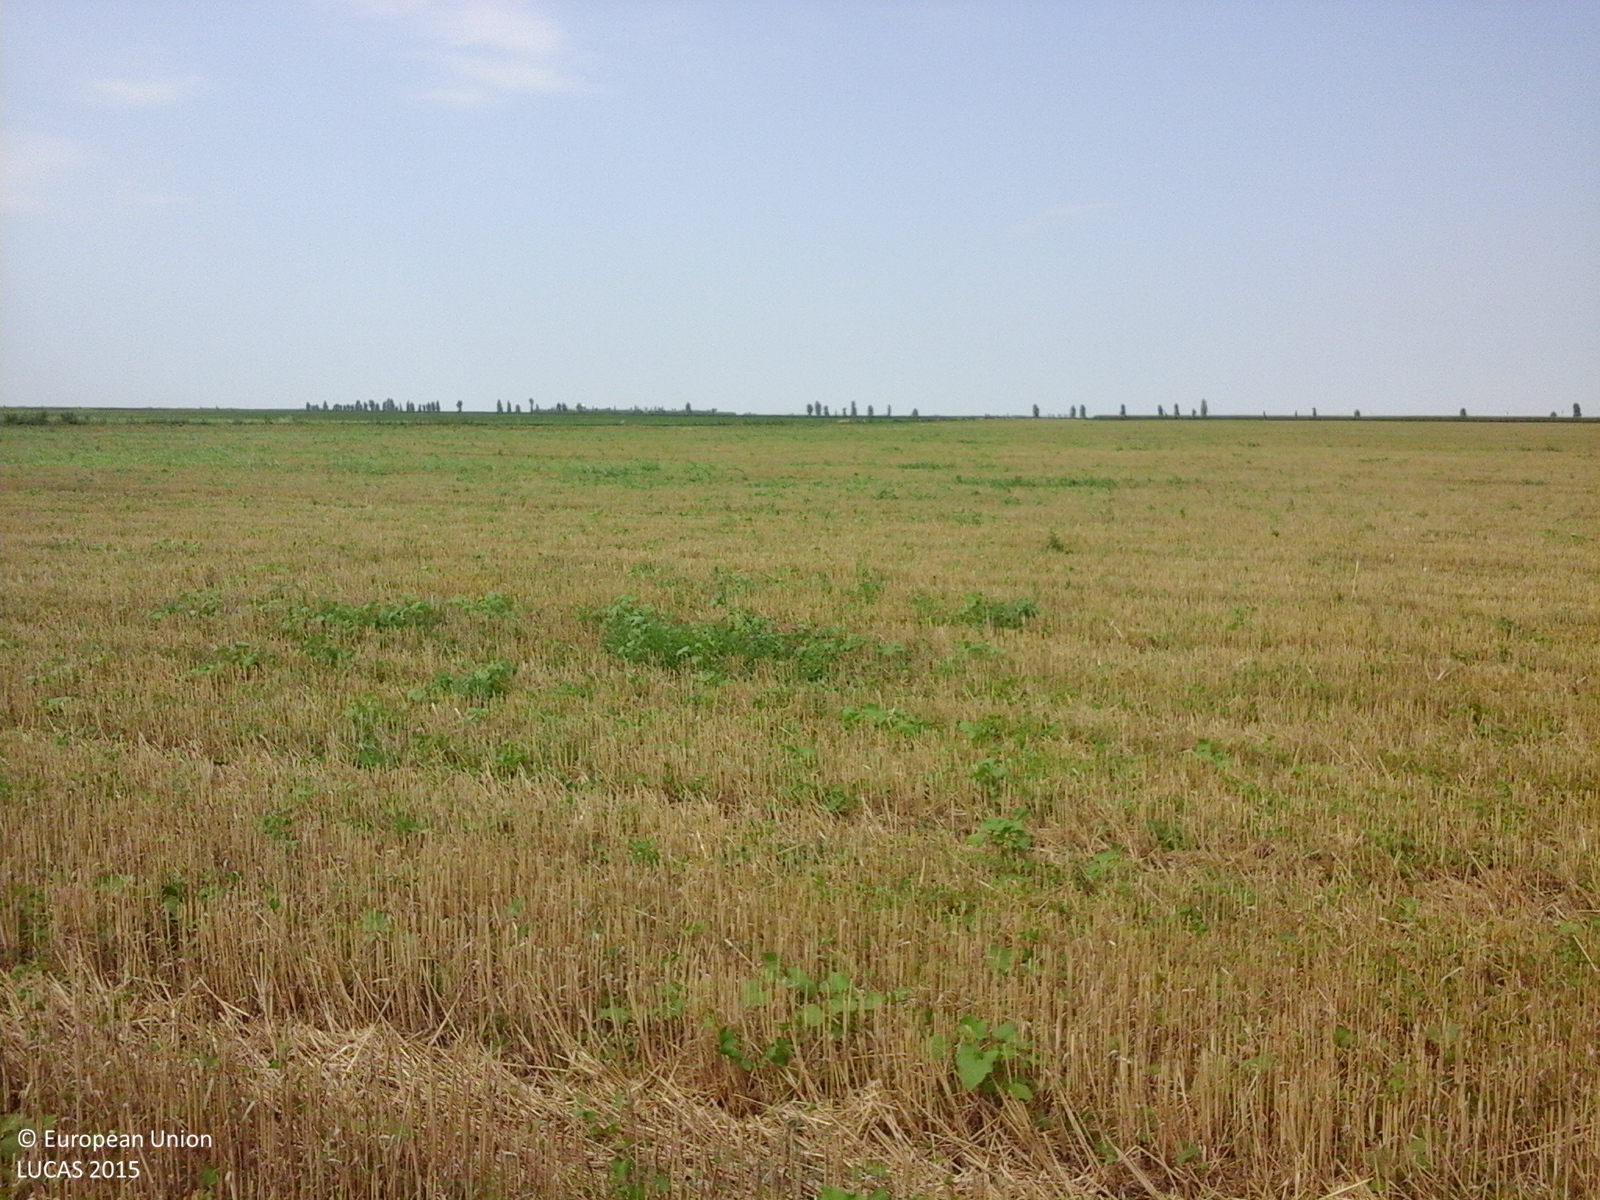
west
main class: Cropland
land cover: Durum wheat
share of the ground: 10 - 25 %
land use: Agriculture (excluding fallow land and kitchen gardens)
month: July
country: RO
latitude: 44.7386
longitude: 26.8865
